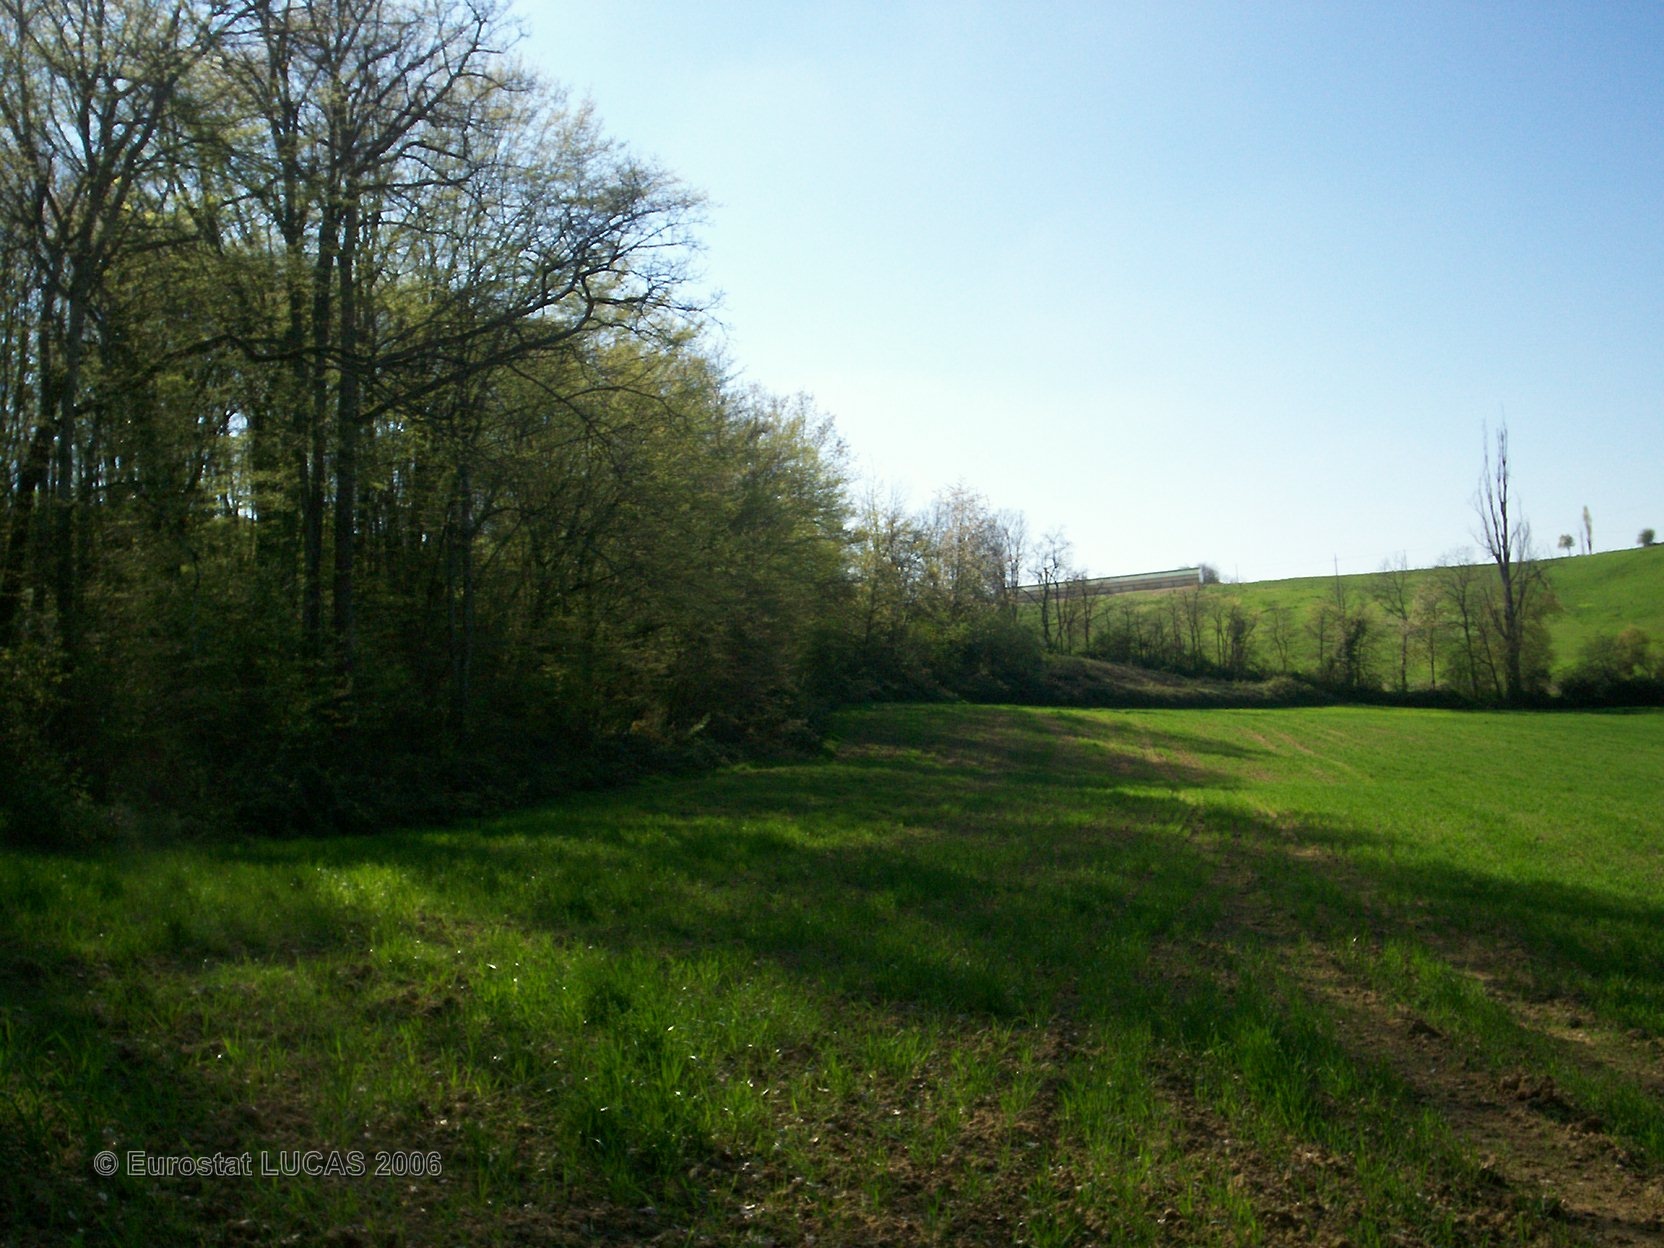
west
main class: Cropland
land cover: Common wheat
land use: Agriculture (excluding fallow land and kitchen gardens)
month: April
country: FR
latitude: 43.5506
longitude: 0.3046
